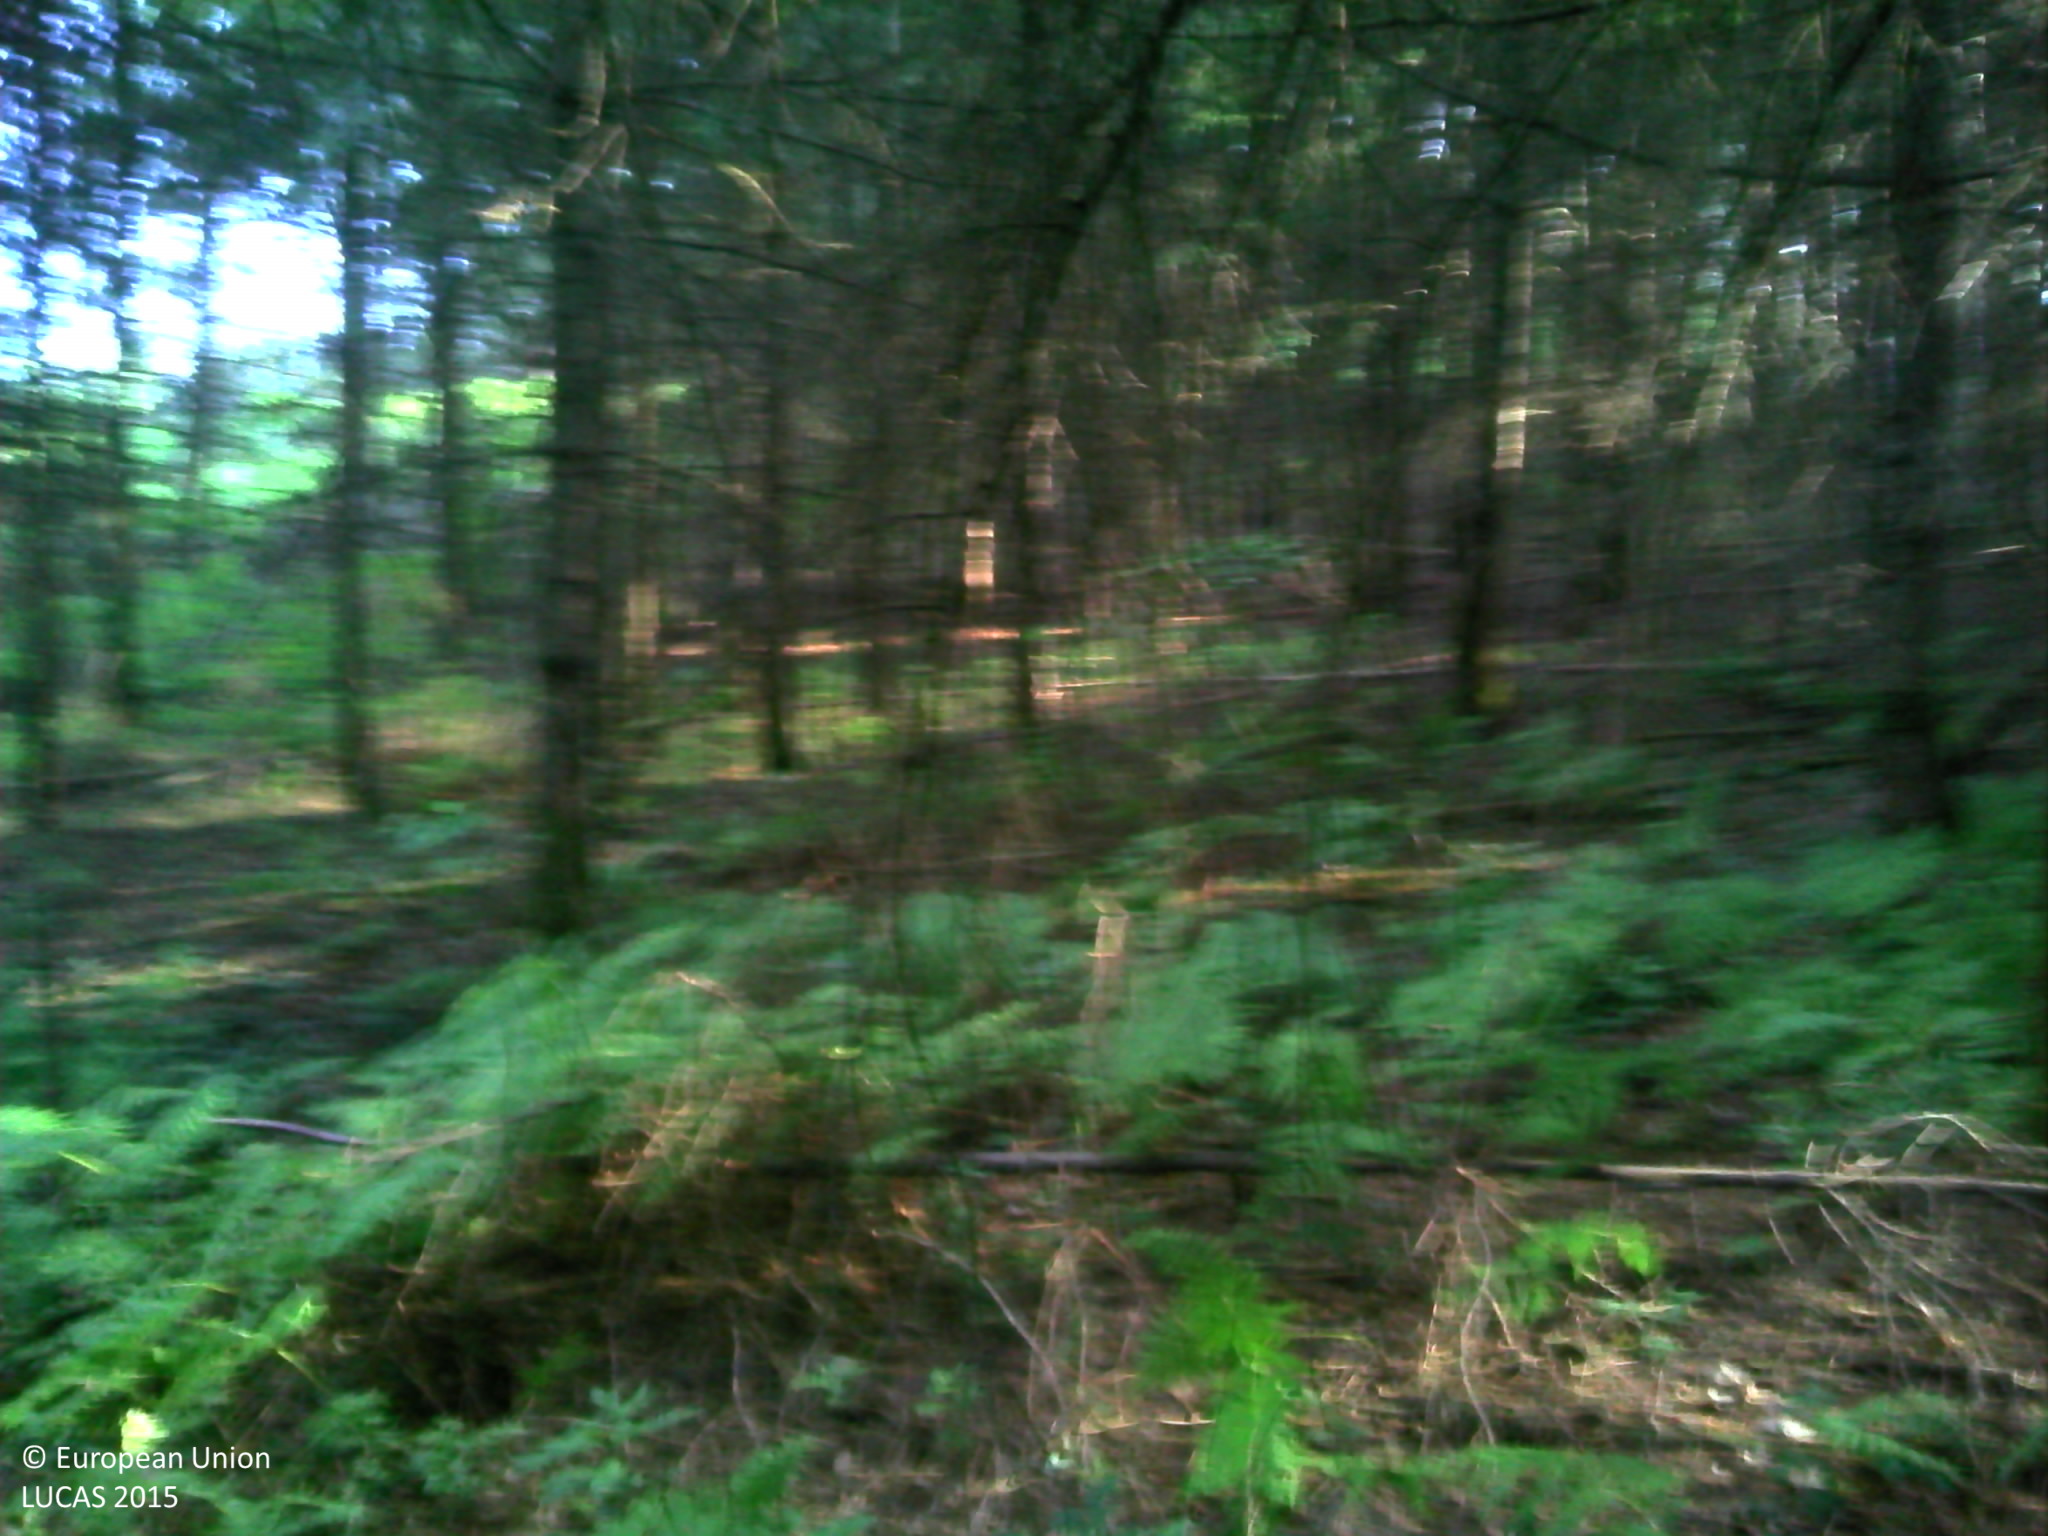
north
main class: Woodland
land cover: Spruce dominated coniferous woodland
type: exotic forest
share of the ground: > 75 %
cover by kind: coniferous forest trees 80 %, herbaceous plants 20 %
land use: Forestry
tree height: > 5 m
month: June
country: FR
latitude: 46.3862
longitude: 4.4231
